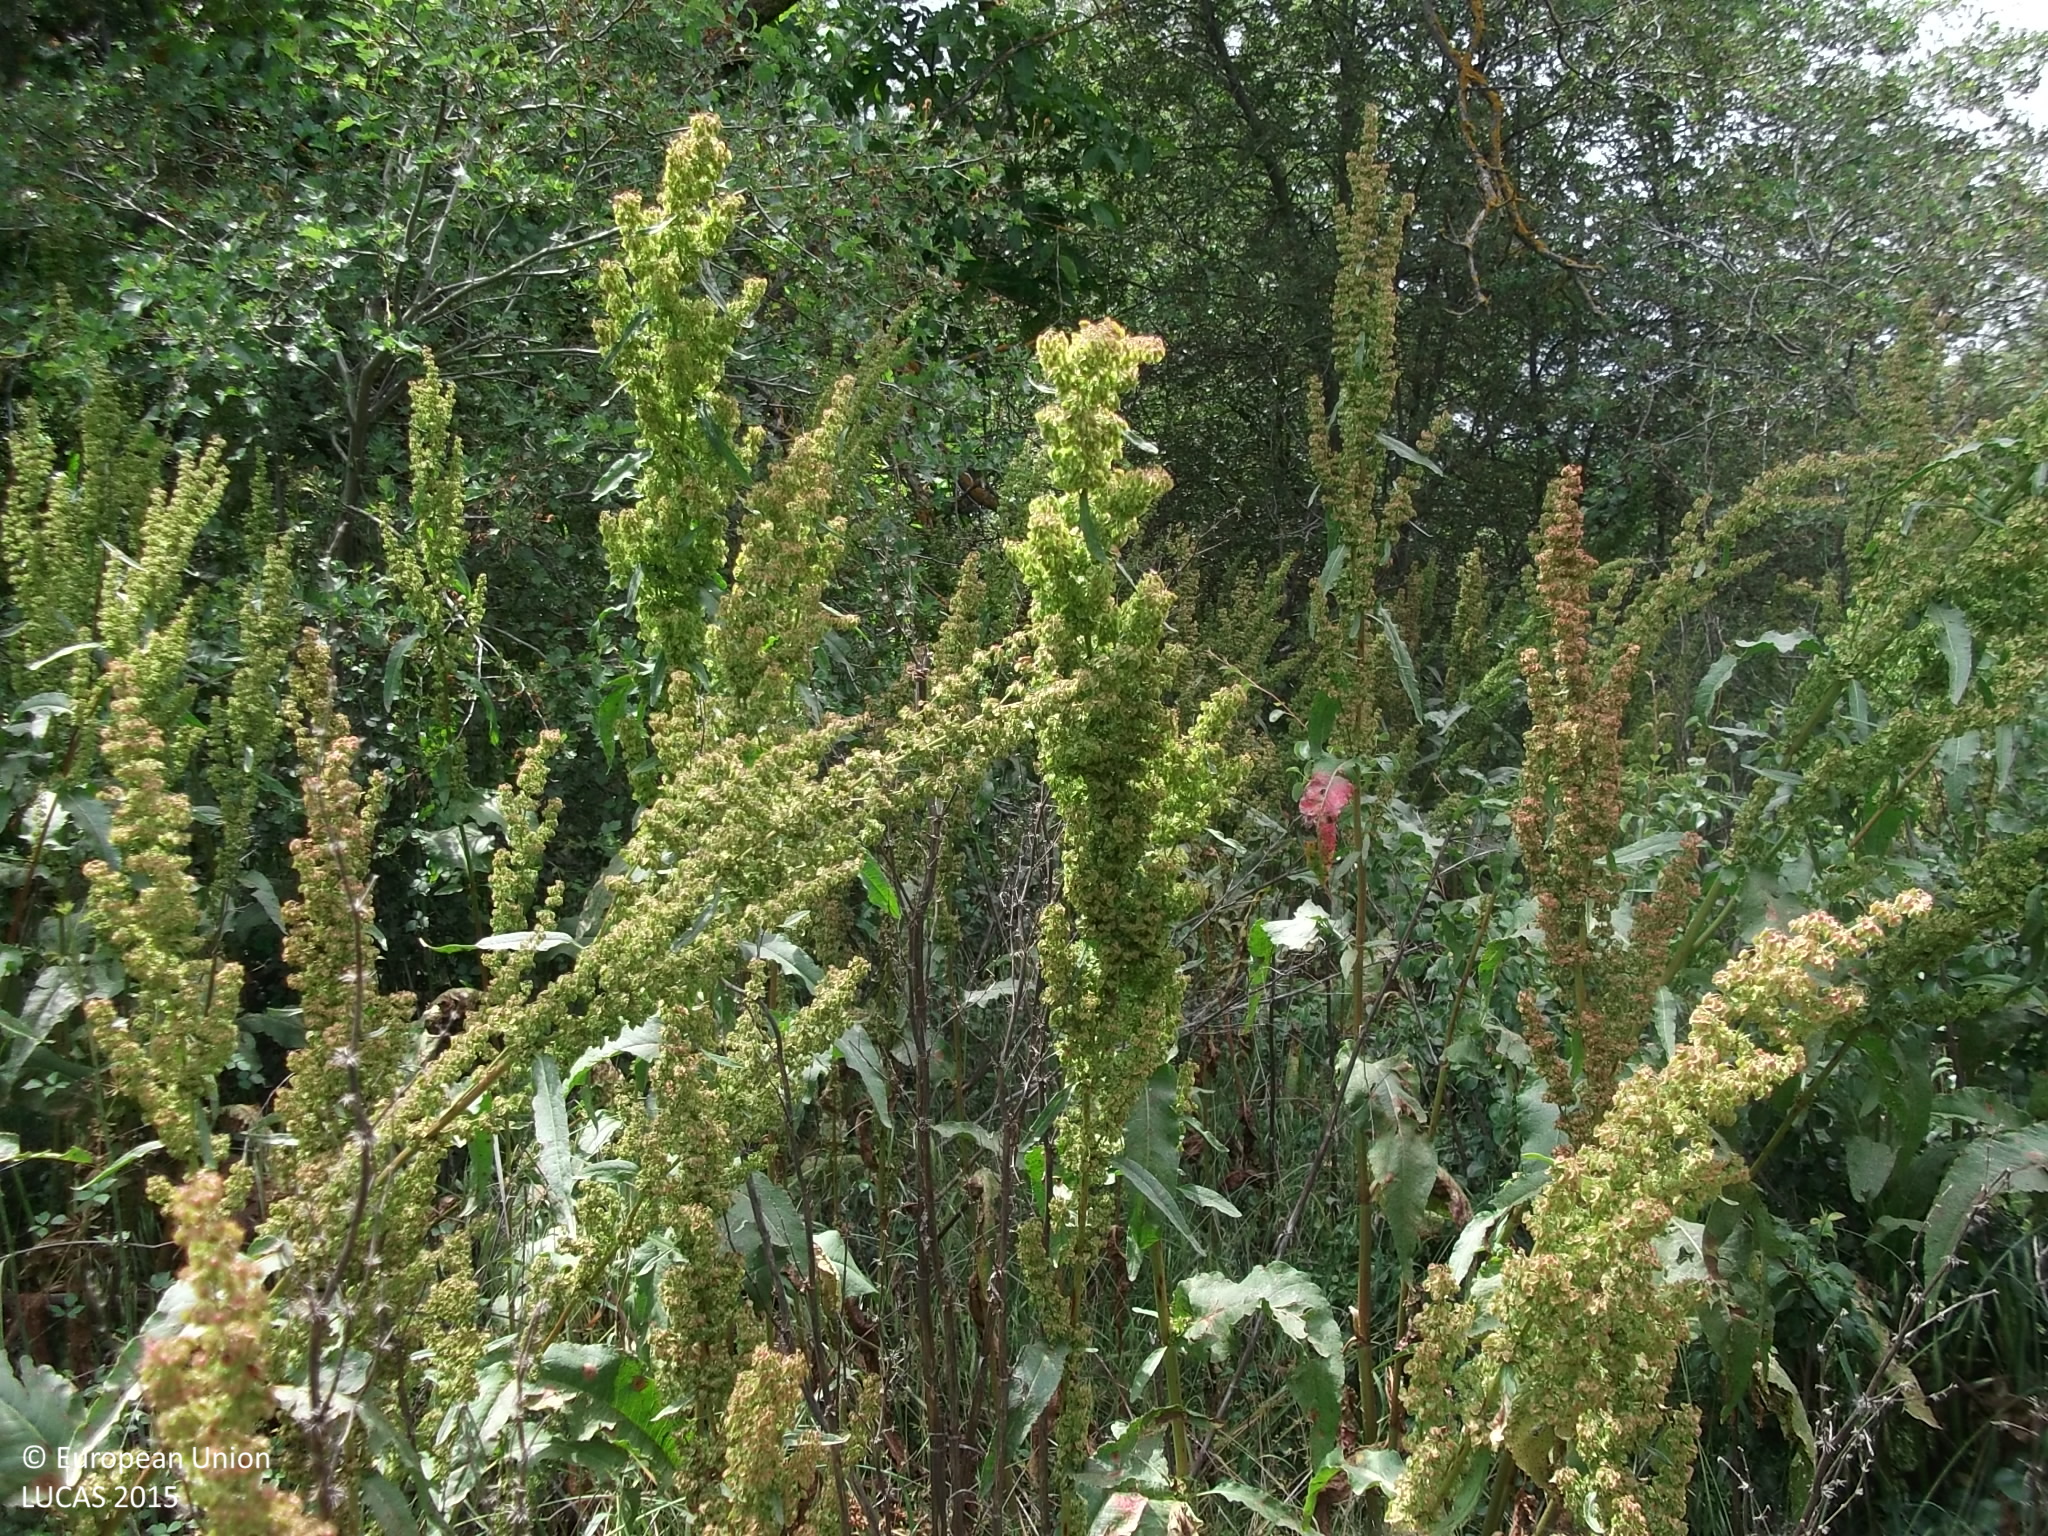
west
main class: Woodland
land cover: Pine dominated coniferous woodland
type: coniferous forest of the mediterranean region
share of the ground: > 75 %
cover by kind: coniferous forest trees 80 %, shrubs 10 %, unconsolidated bare surface 10 %
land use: Semi-natural and natural areas not in use
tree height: > 5 m
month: June
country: CY
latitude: 34.9544
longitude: 32.9591
